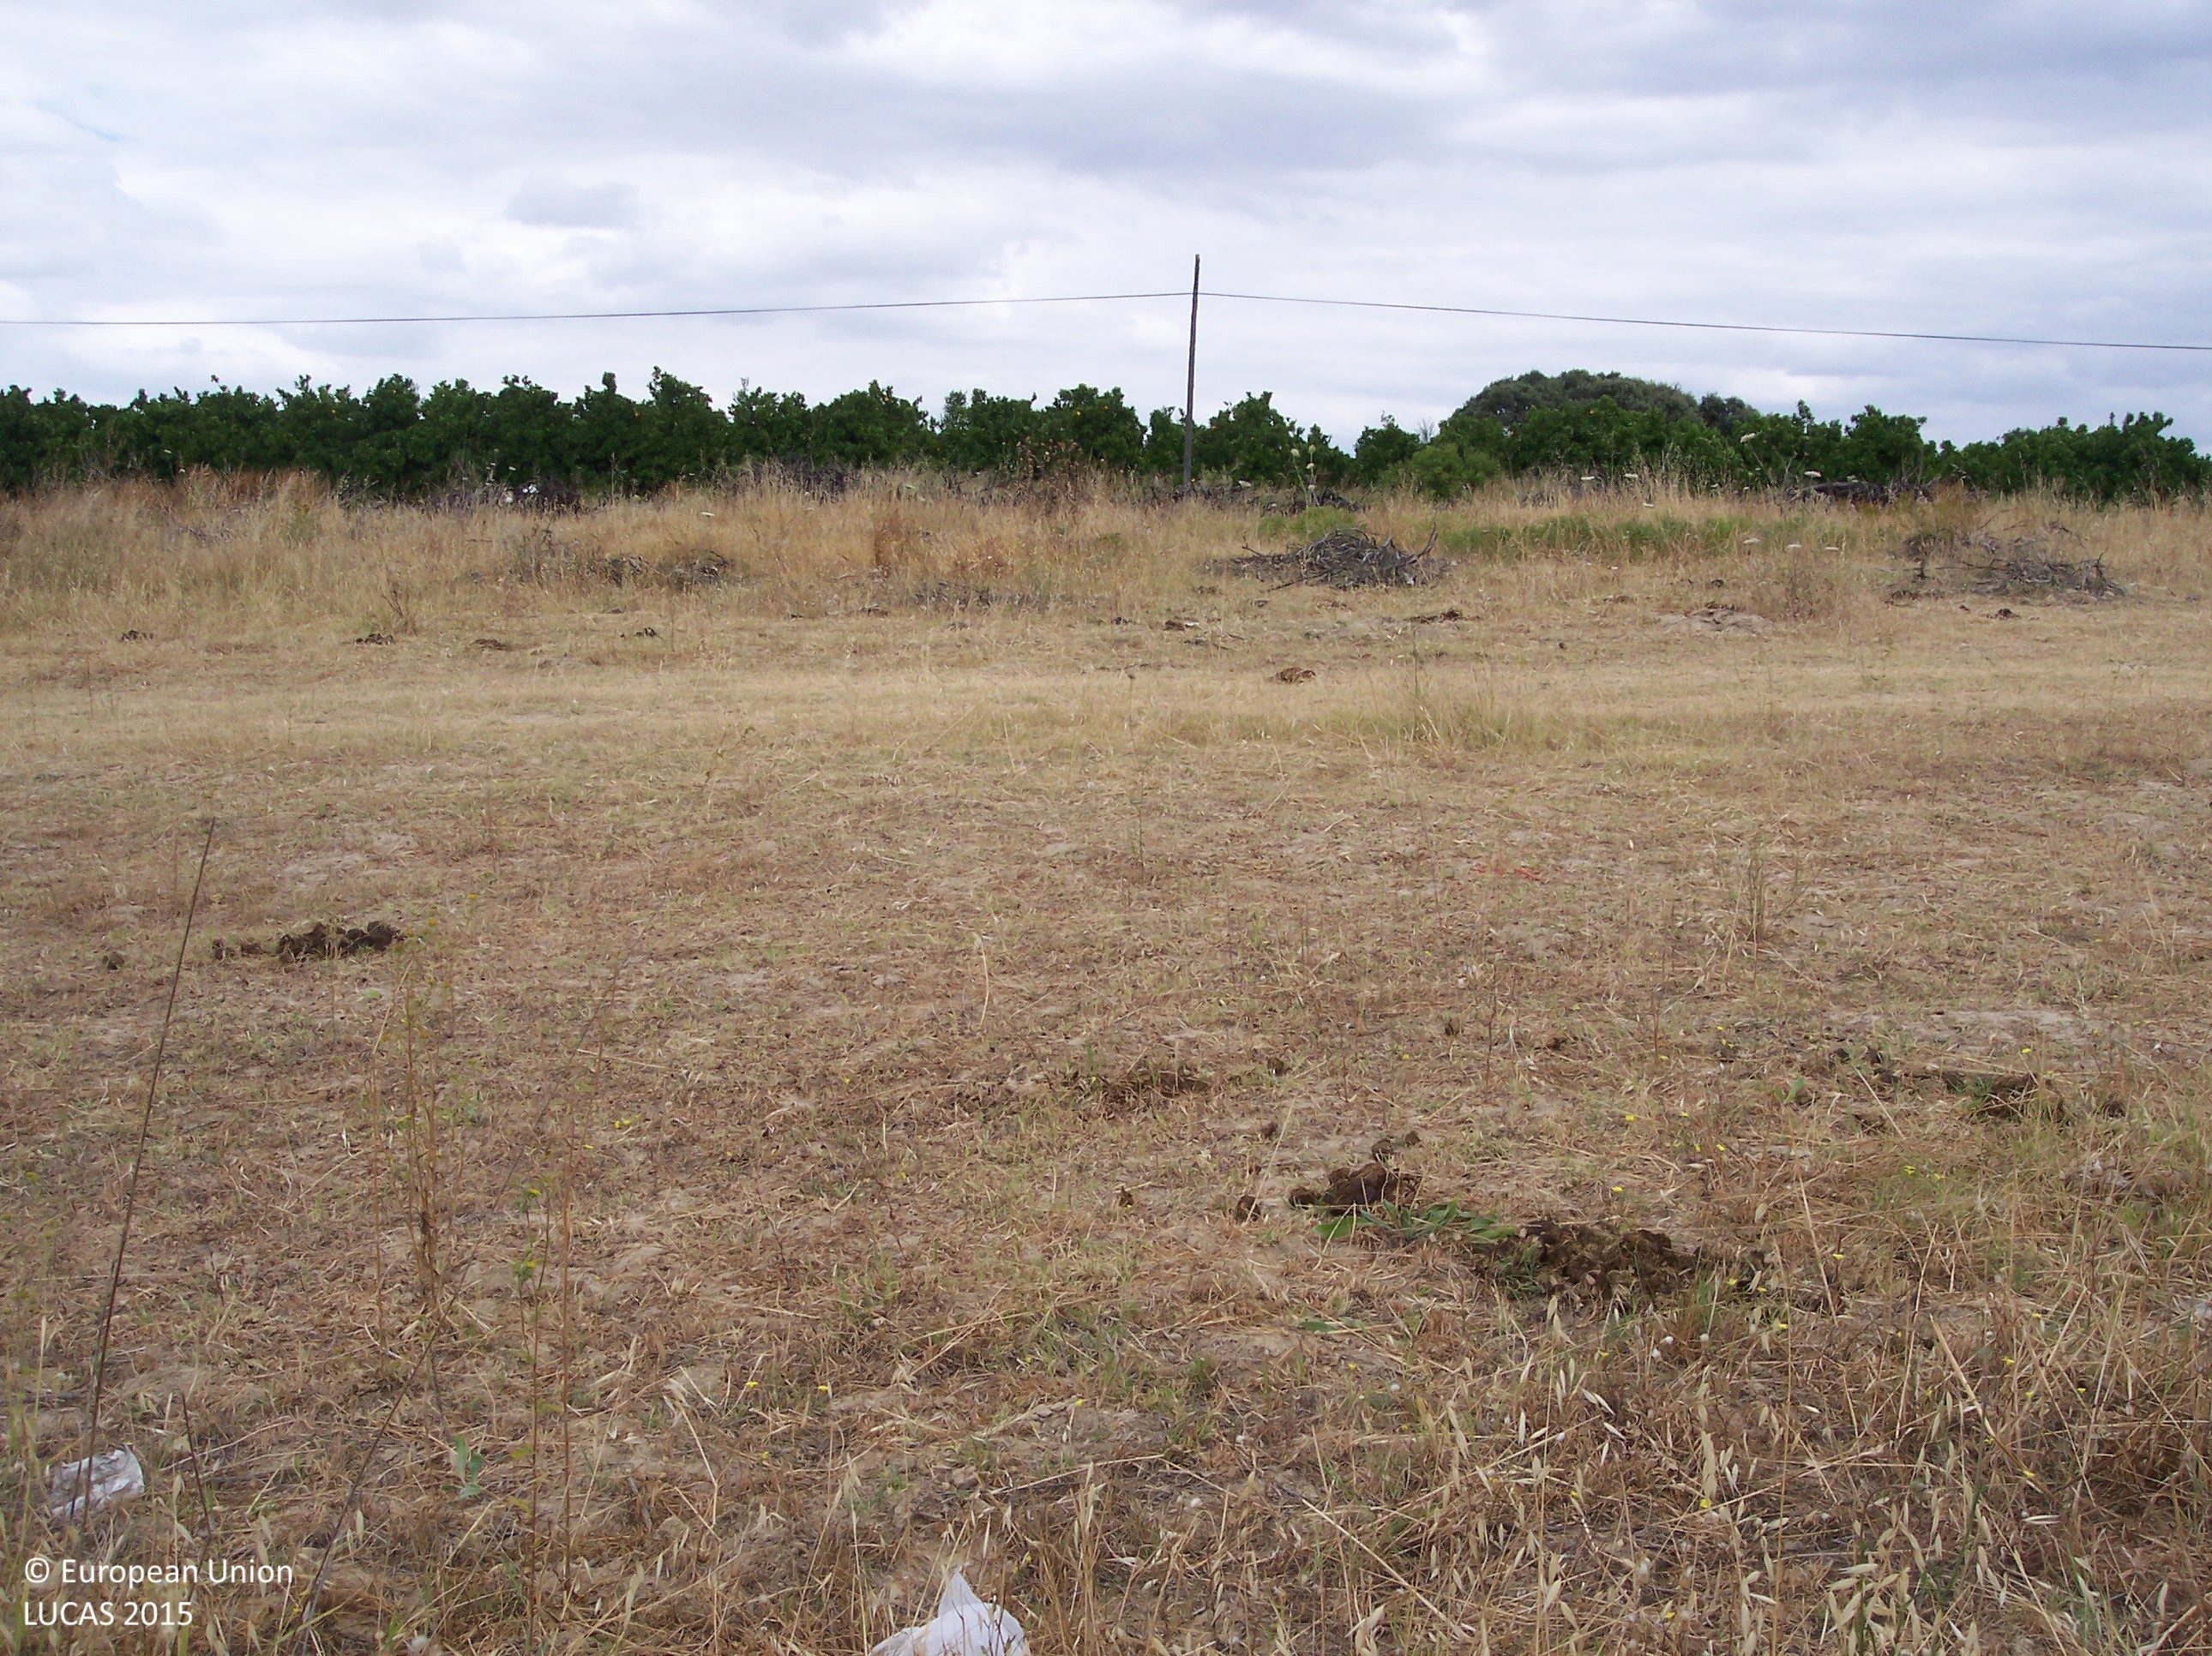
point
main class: Grassland
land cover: Grassland without tree/shrub cover
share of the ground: > 75 %
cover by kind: herbaceous plants 75 %, unconsolidated bare surface 20 %, shrubs 5 %
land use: Agriculture (excluding fallow land and kitchen gardens)
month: June
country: ES
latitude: 37.3135
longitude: -6.3786
